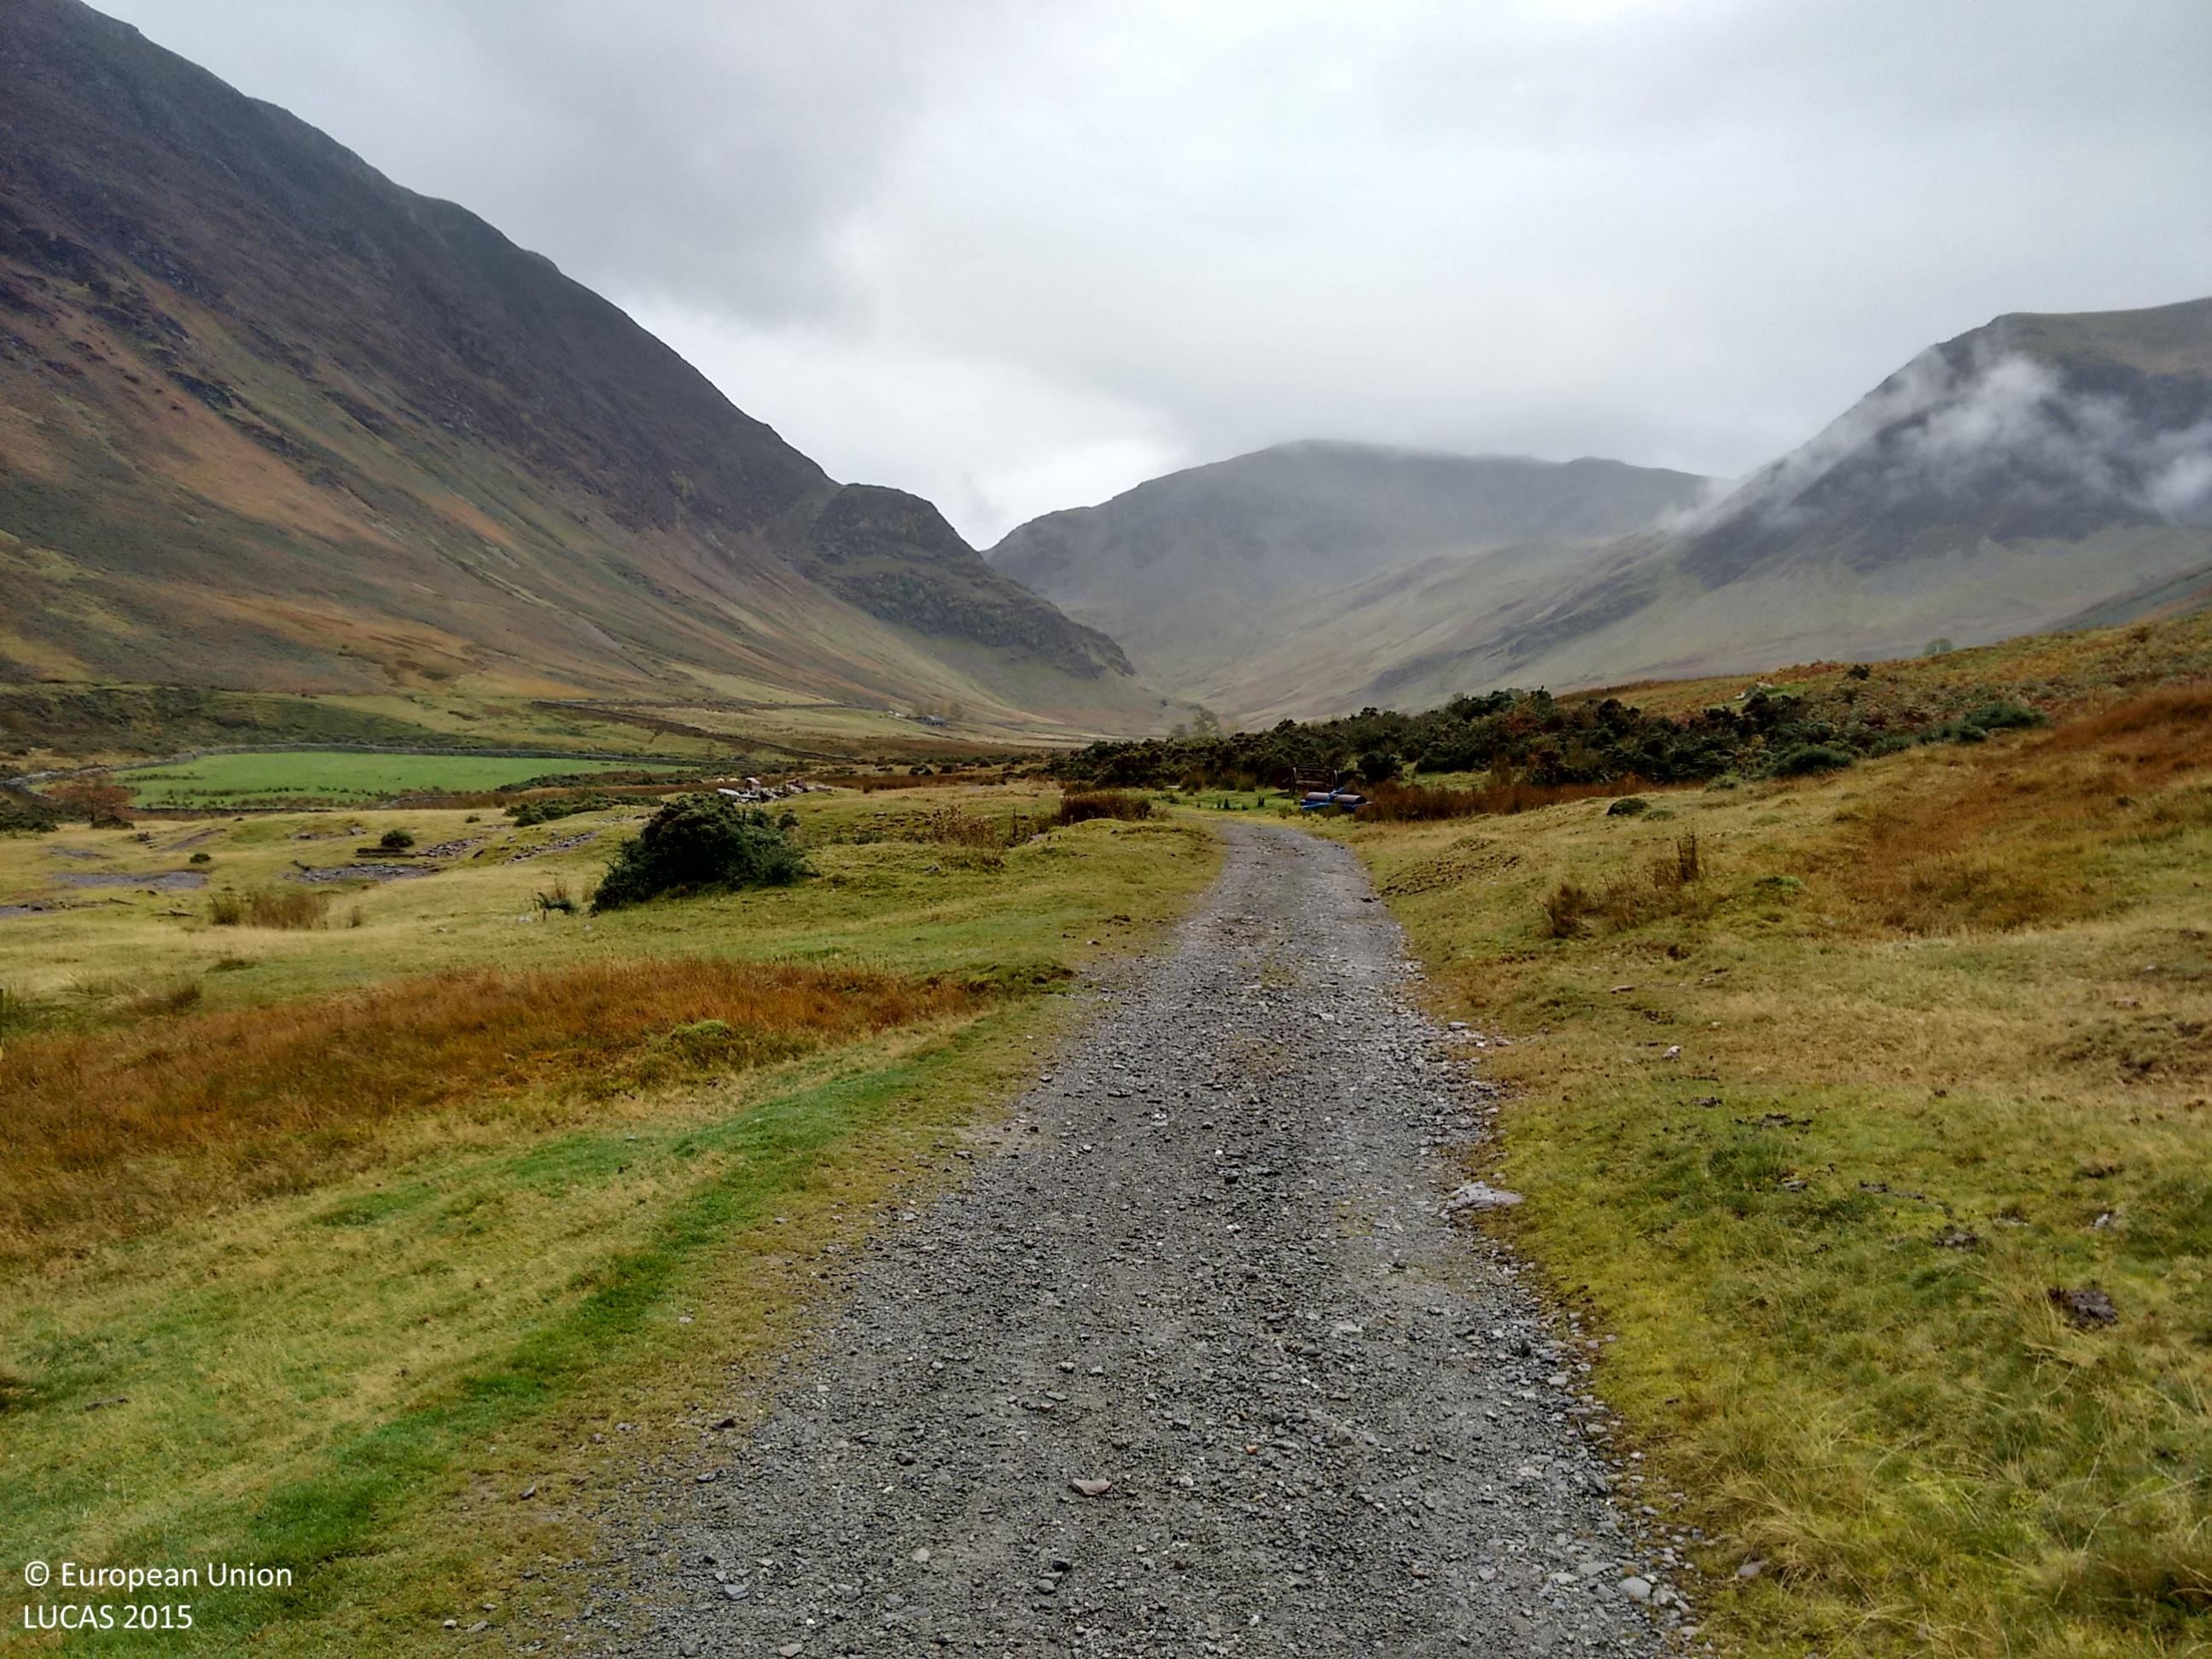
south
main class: Shrubland
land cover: Shrubland without tree cover
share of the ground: > 75 %
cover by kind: shrubs 100 %
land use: Agriculture (excluding fallow land and kitchen gardens)
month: October
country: GB
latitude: 54.5530
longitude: -3.2028
